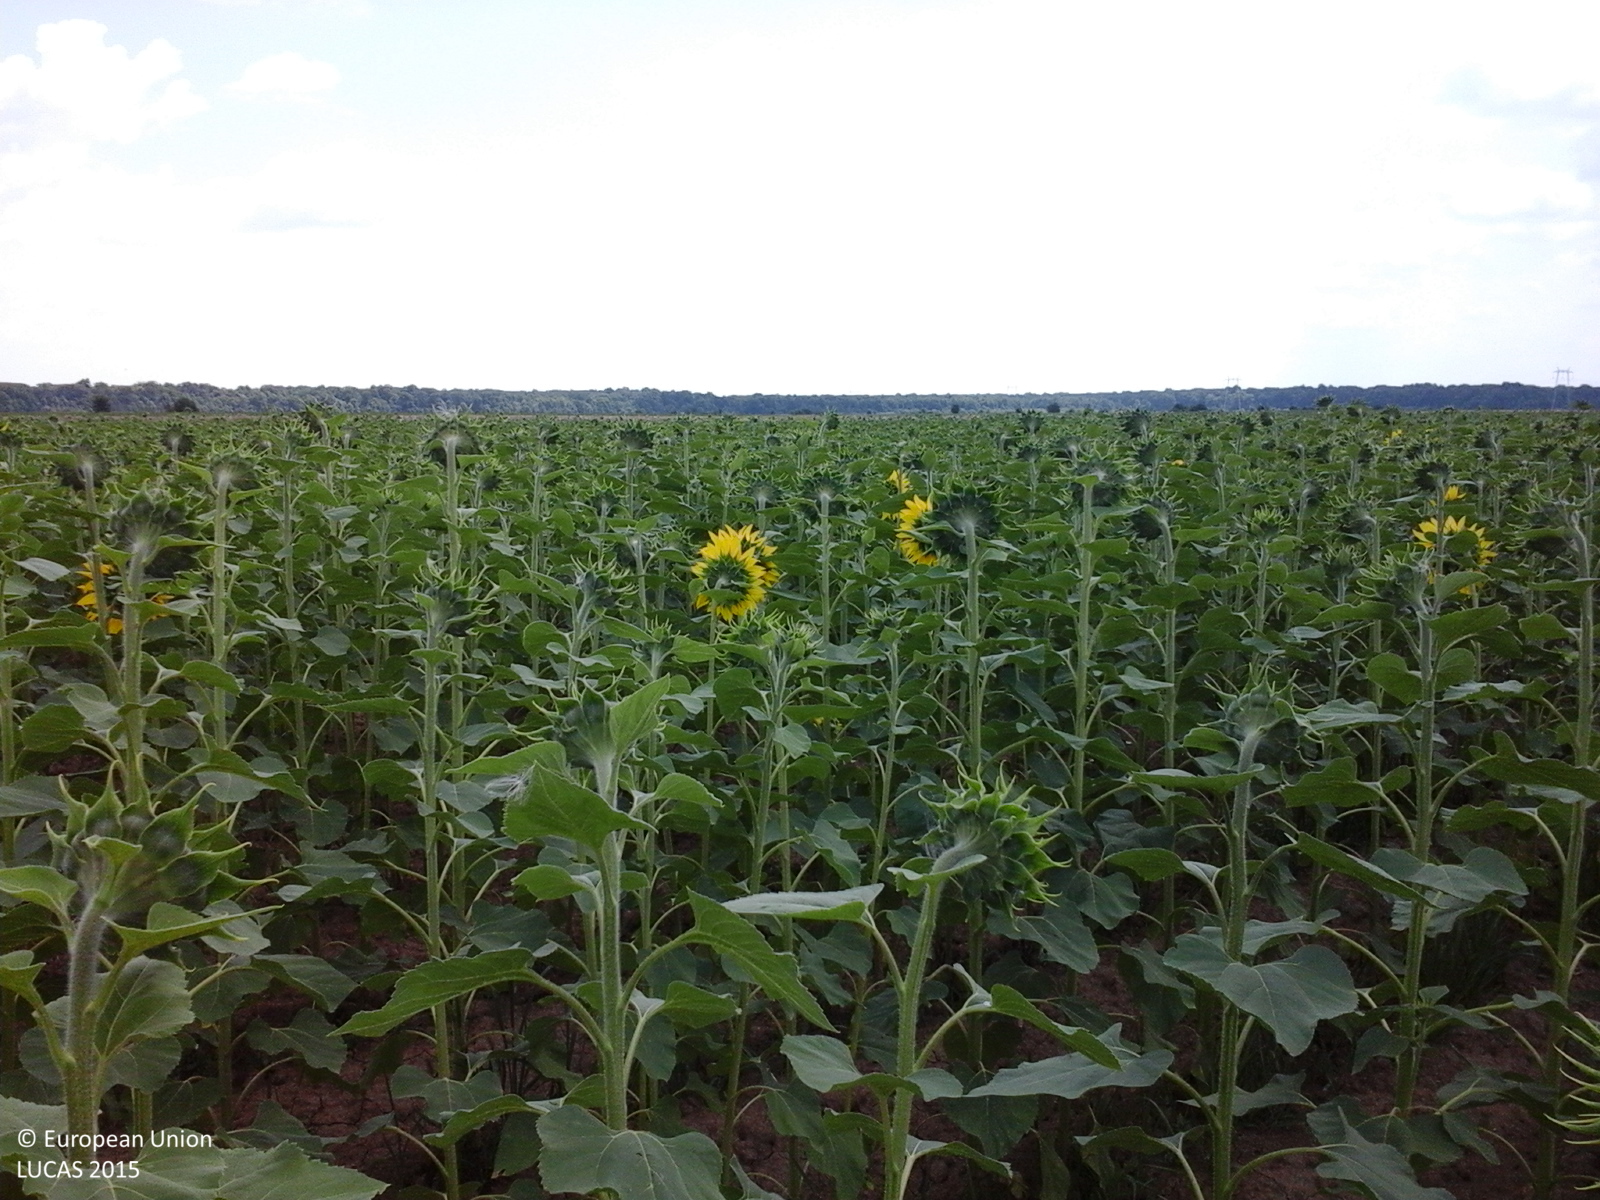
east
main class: Grassland
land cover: Spontaneously vegetated surfaces
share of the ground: > 75 %
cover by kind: herbaceous plants 100 %
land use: Fallow land
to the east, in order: Spontaneously vegetated surfaces; Sunflower; Maize; Spontaneously vegetated surfaces
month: July
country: RO
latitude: 44.4618
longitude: 25.6165
